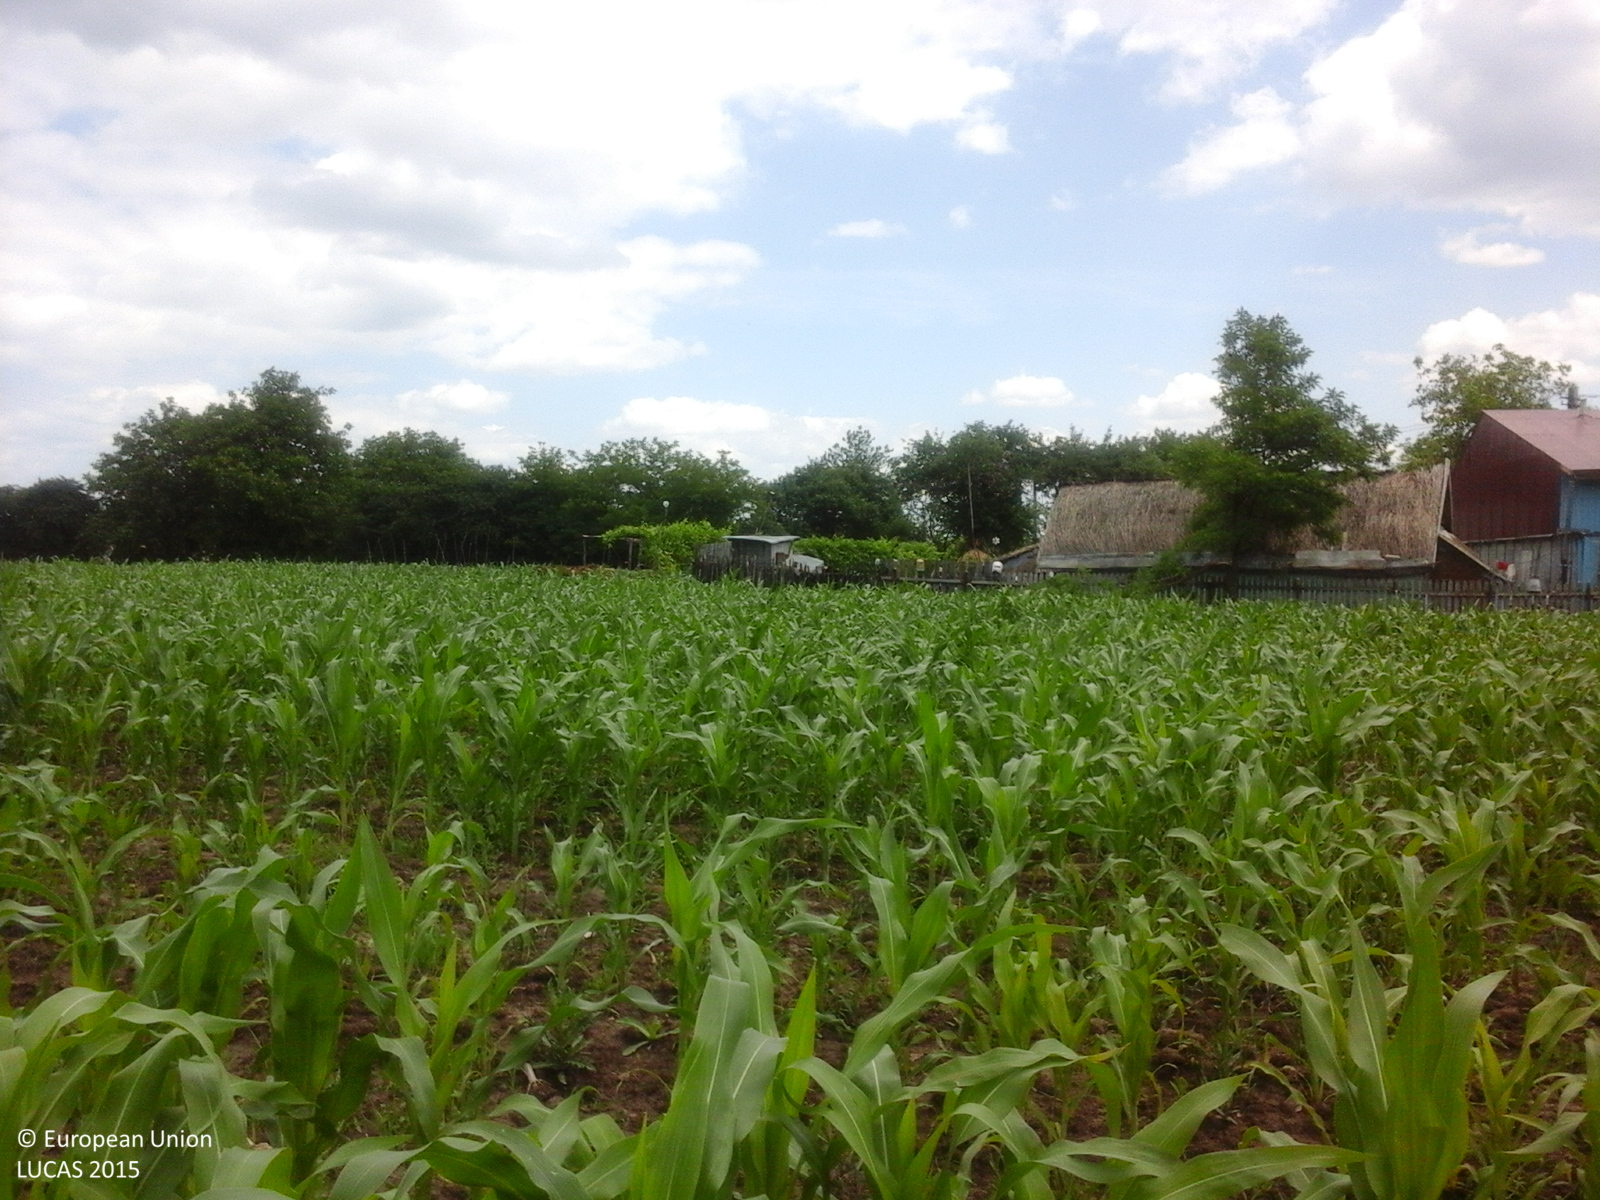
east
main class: Cropland
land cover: Maize
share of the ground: 50 - 75 %
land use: Agriculture (excluding fallow land and kitchen gardens)
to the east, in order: Maize; Other fresh vegetables; Maize; Artificial constructions in urban areas; Potatoes; Lines of trees; Fences; Artificial constructions in urban areas; Potatoes; Fences; Broadleaved woodland; Grassland without tree/shrub cover
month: June
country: RO
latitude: 47.8114
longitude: 26.3934
